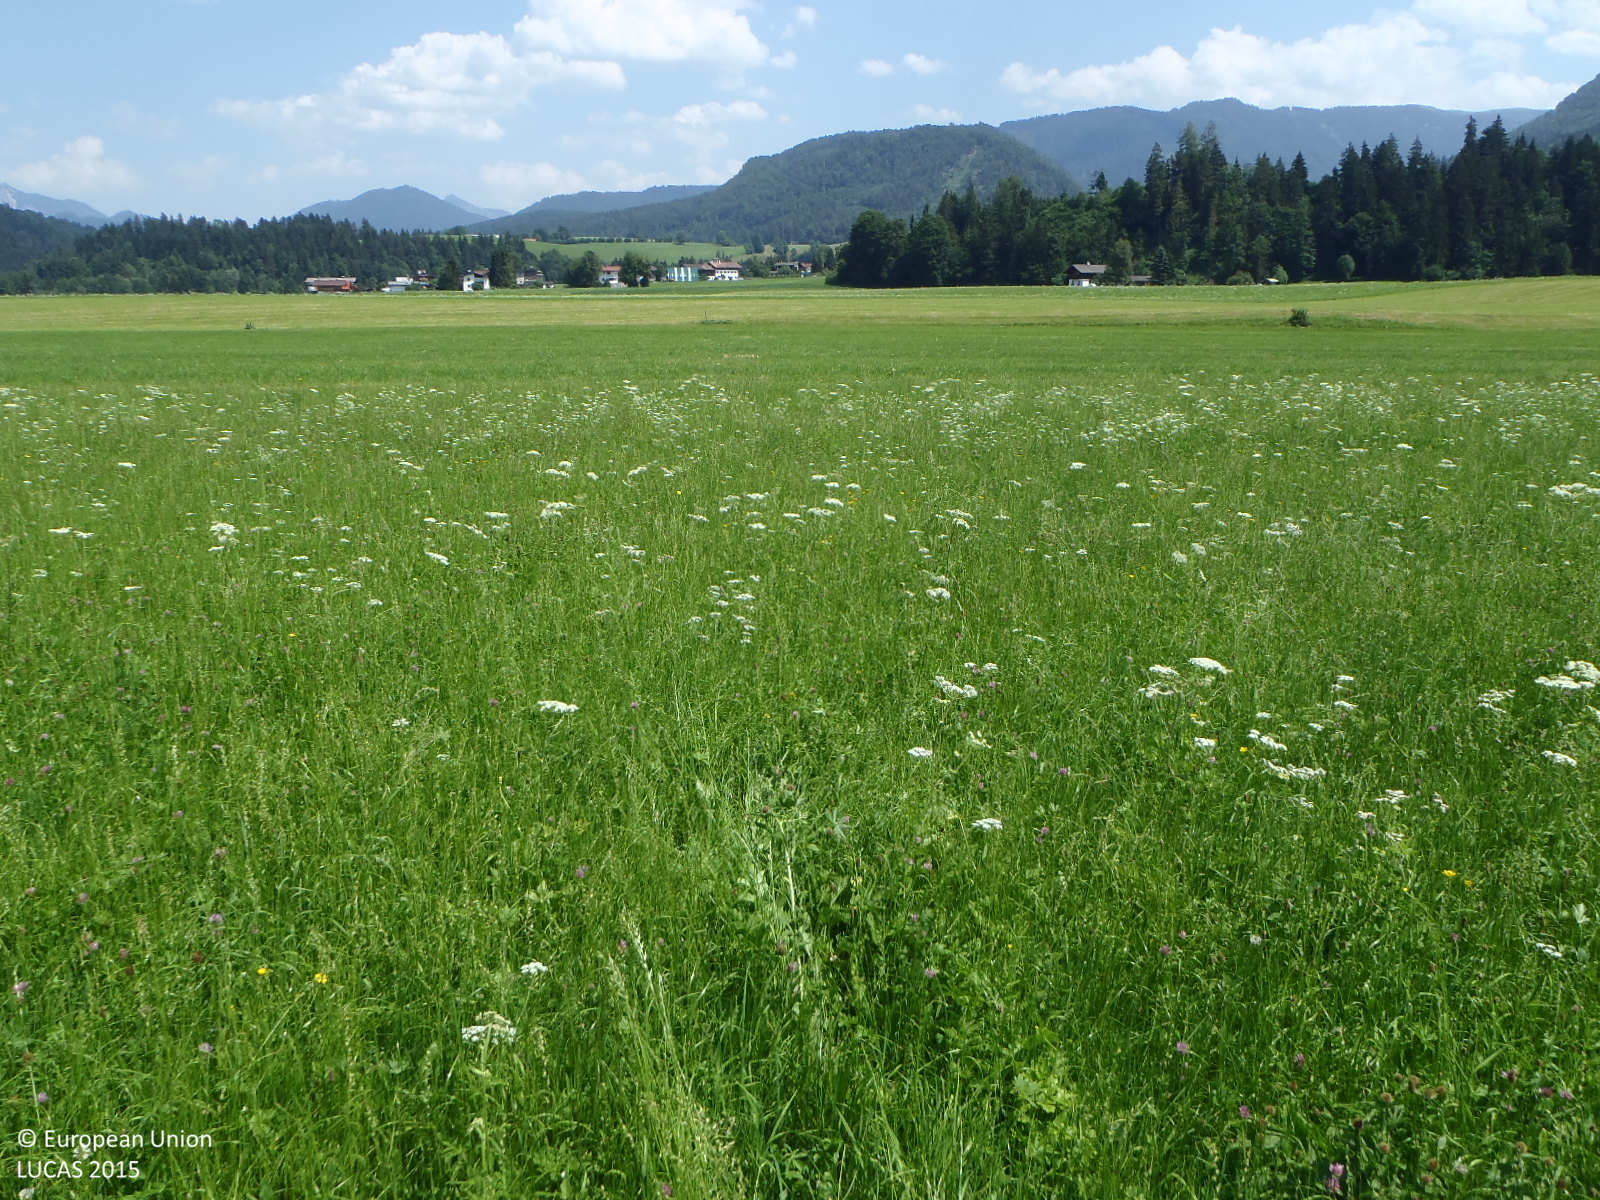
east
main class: Grassland
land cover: Grassland without tree/shrub cover
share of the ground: > 75 %
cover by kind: herbaceous plants 100 %
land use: Agriculture (excluding fallow land and kitchen gardens)
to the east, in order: Grassland without tree/shrub cover
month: July
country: AT
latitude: 47.6571
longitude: 12.4085
